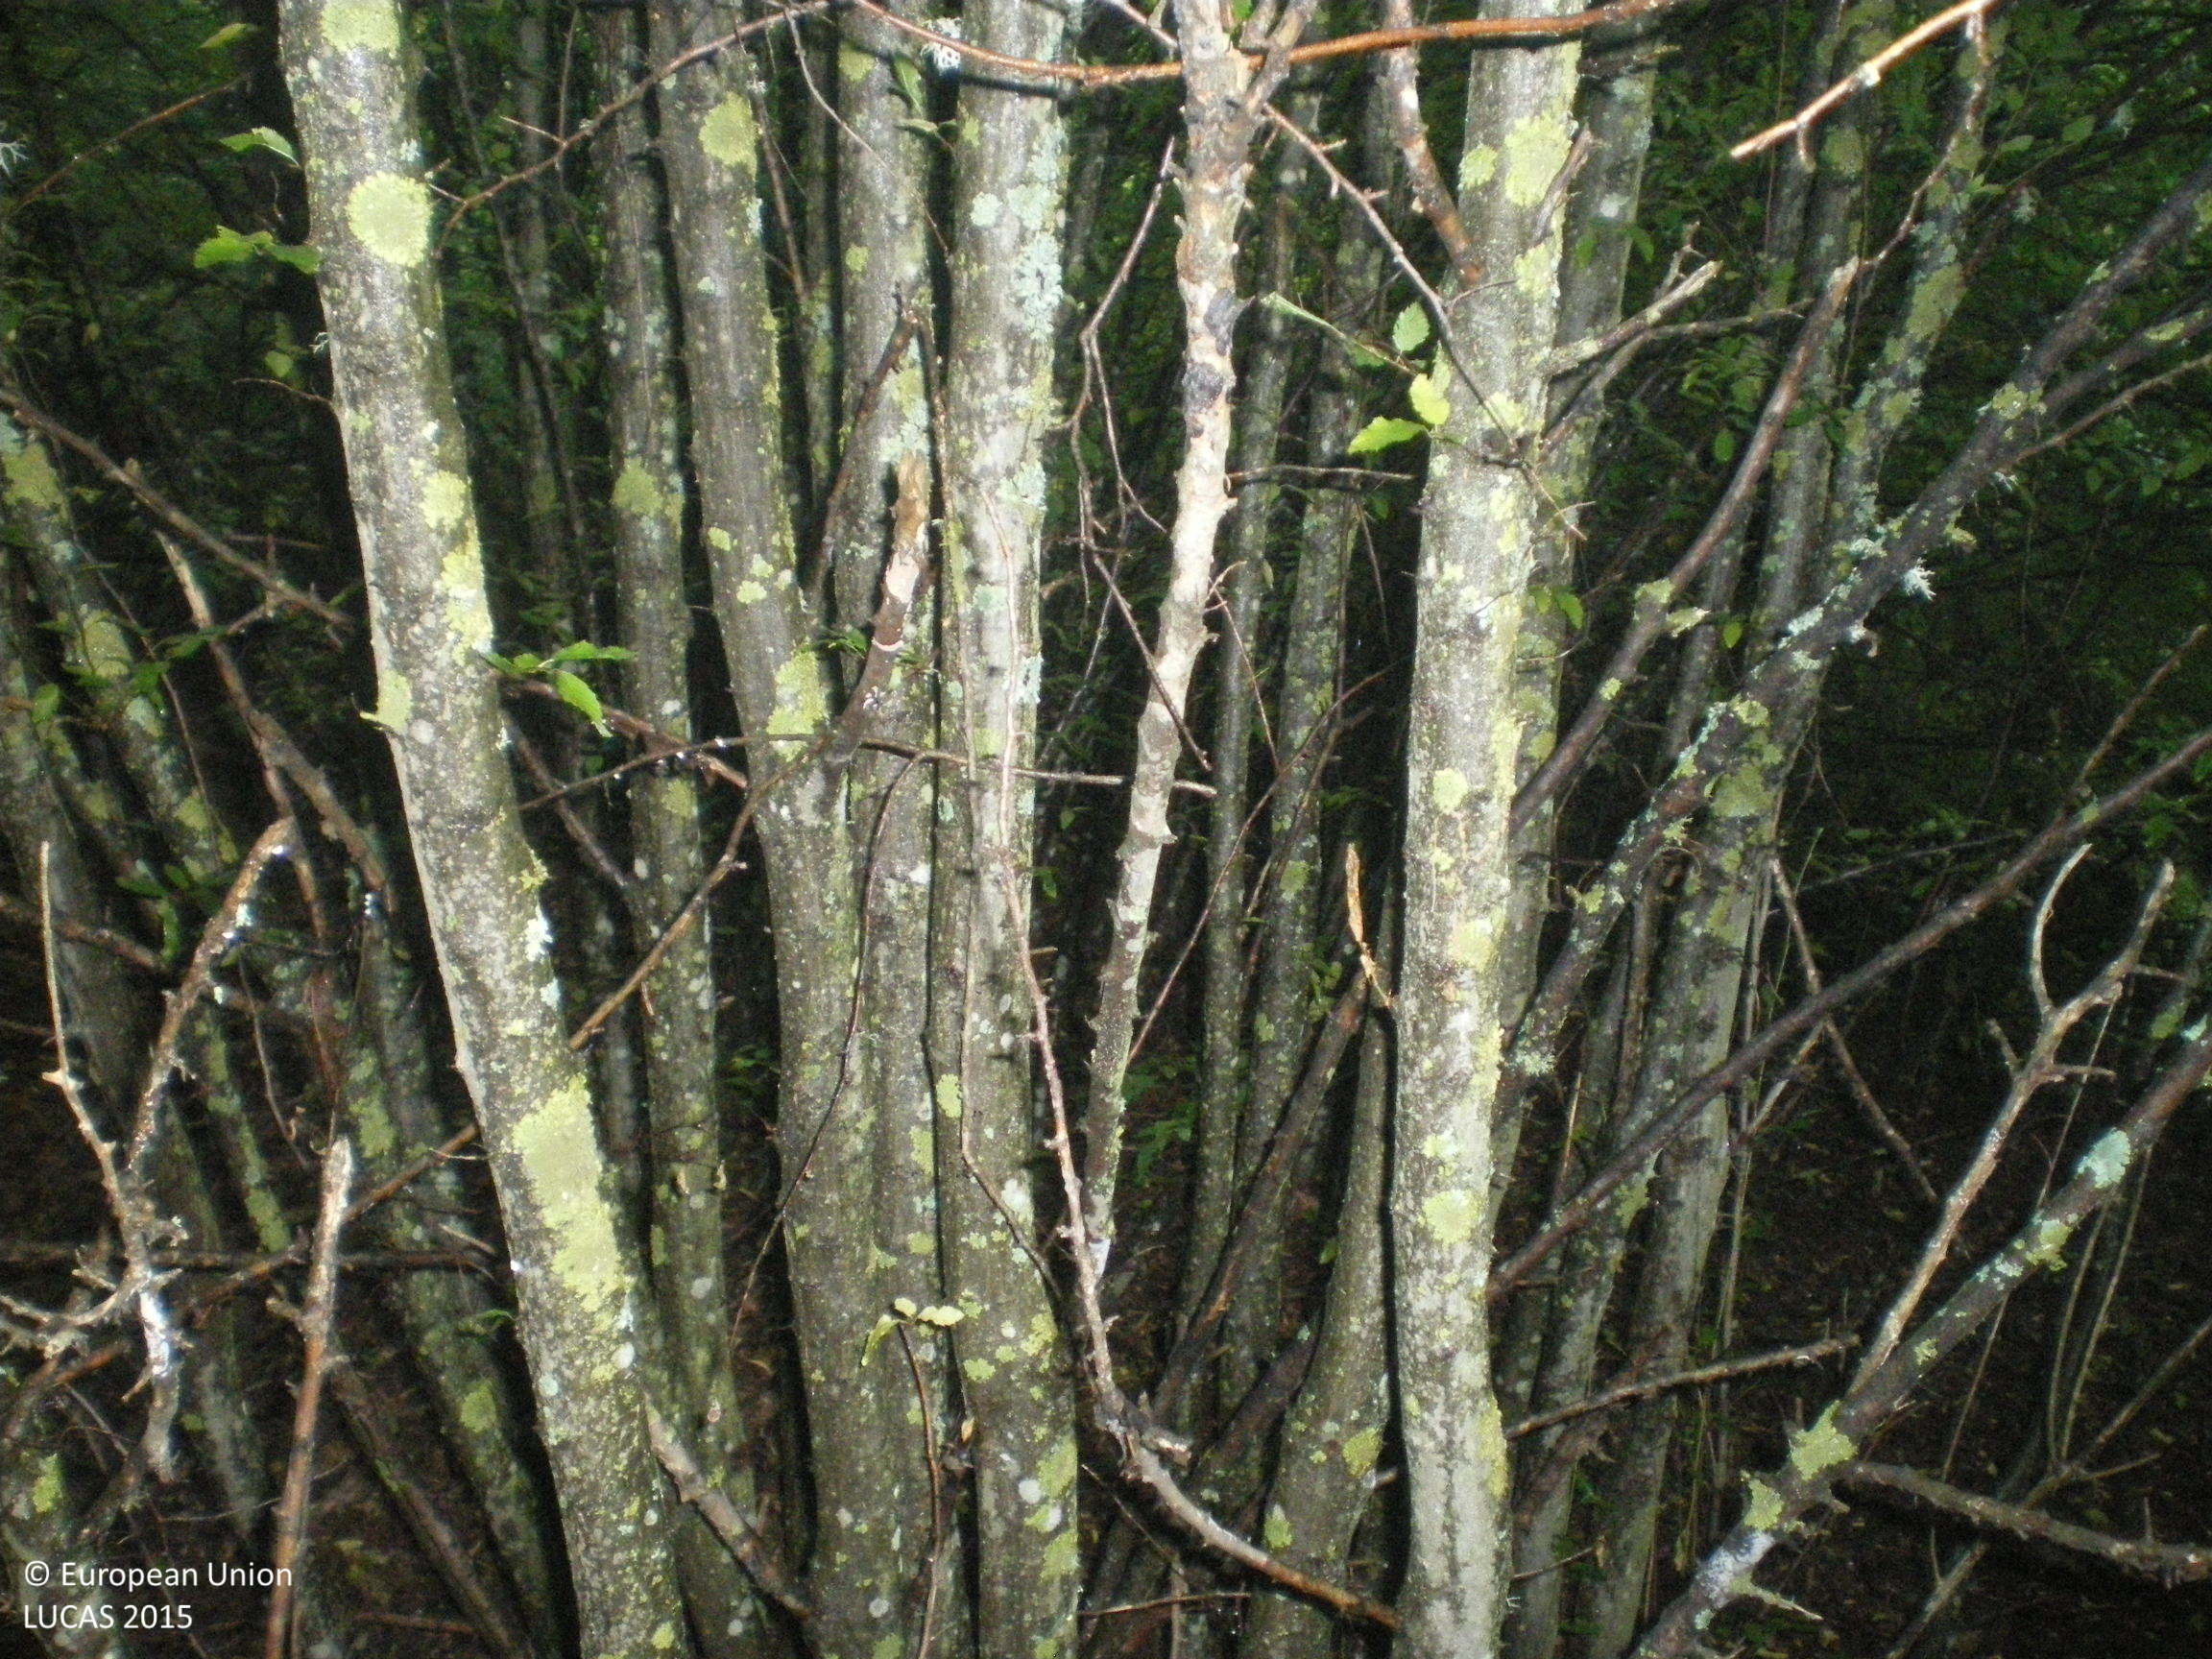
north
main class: Woodland
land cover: Broadleaved woodland
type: mesophytic deciduous forest
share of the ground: > 75 %
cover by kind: broadleaved forest trees 95 %, unconsolidated bare surface 5 %
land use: Forestry
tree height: > 5 m
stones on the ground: < 10 %
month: July
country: BG
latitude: 42.4241
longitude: 25.2690
